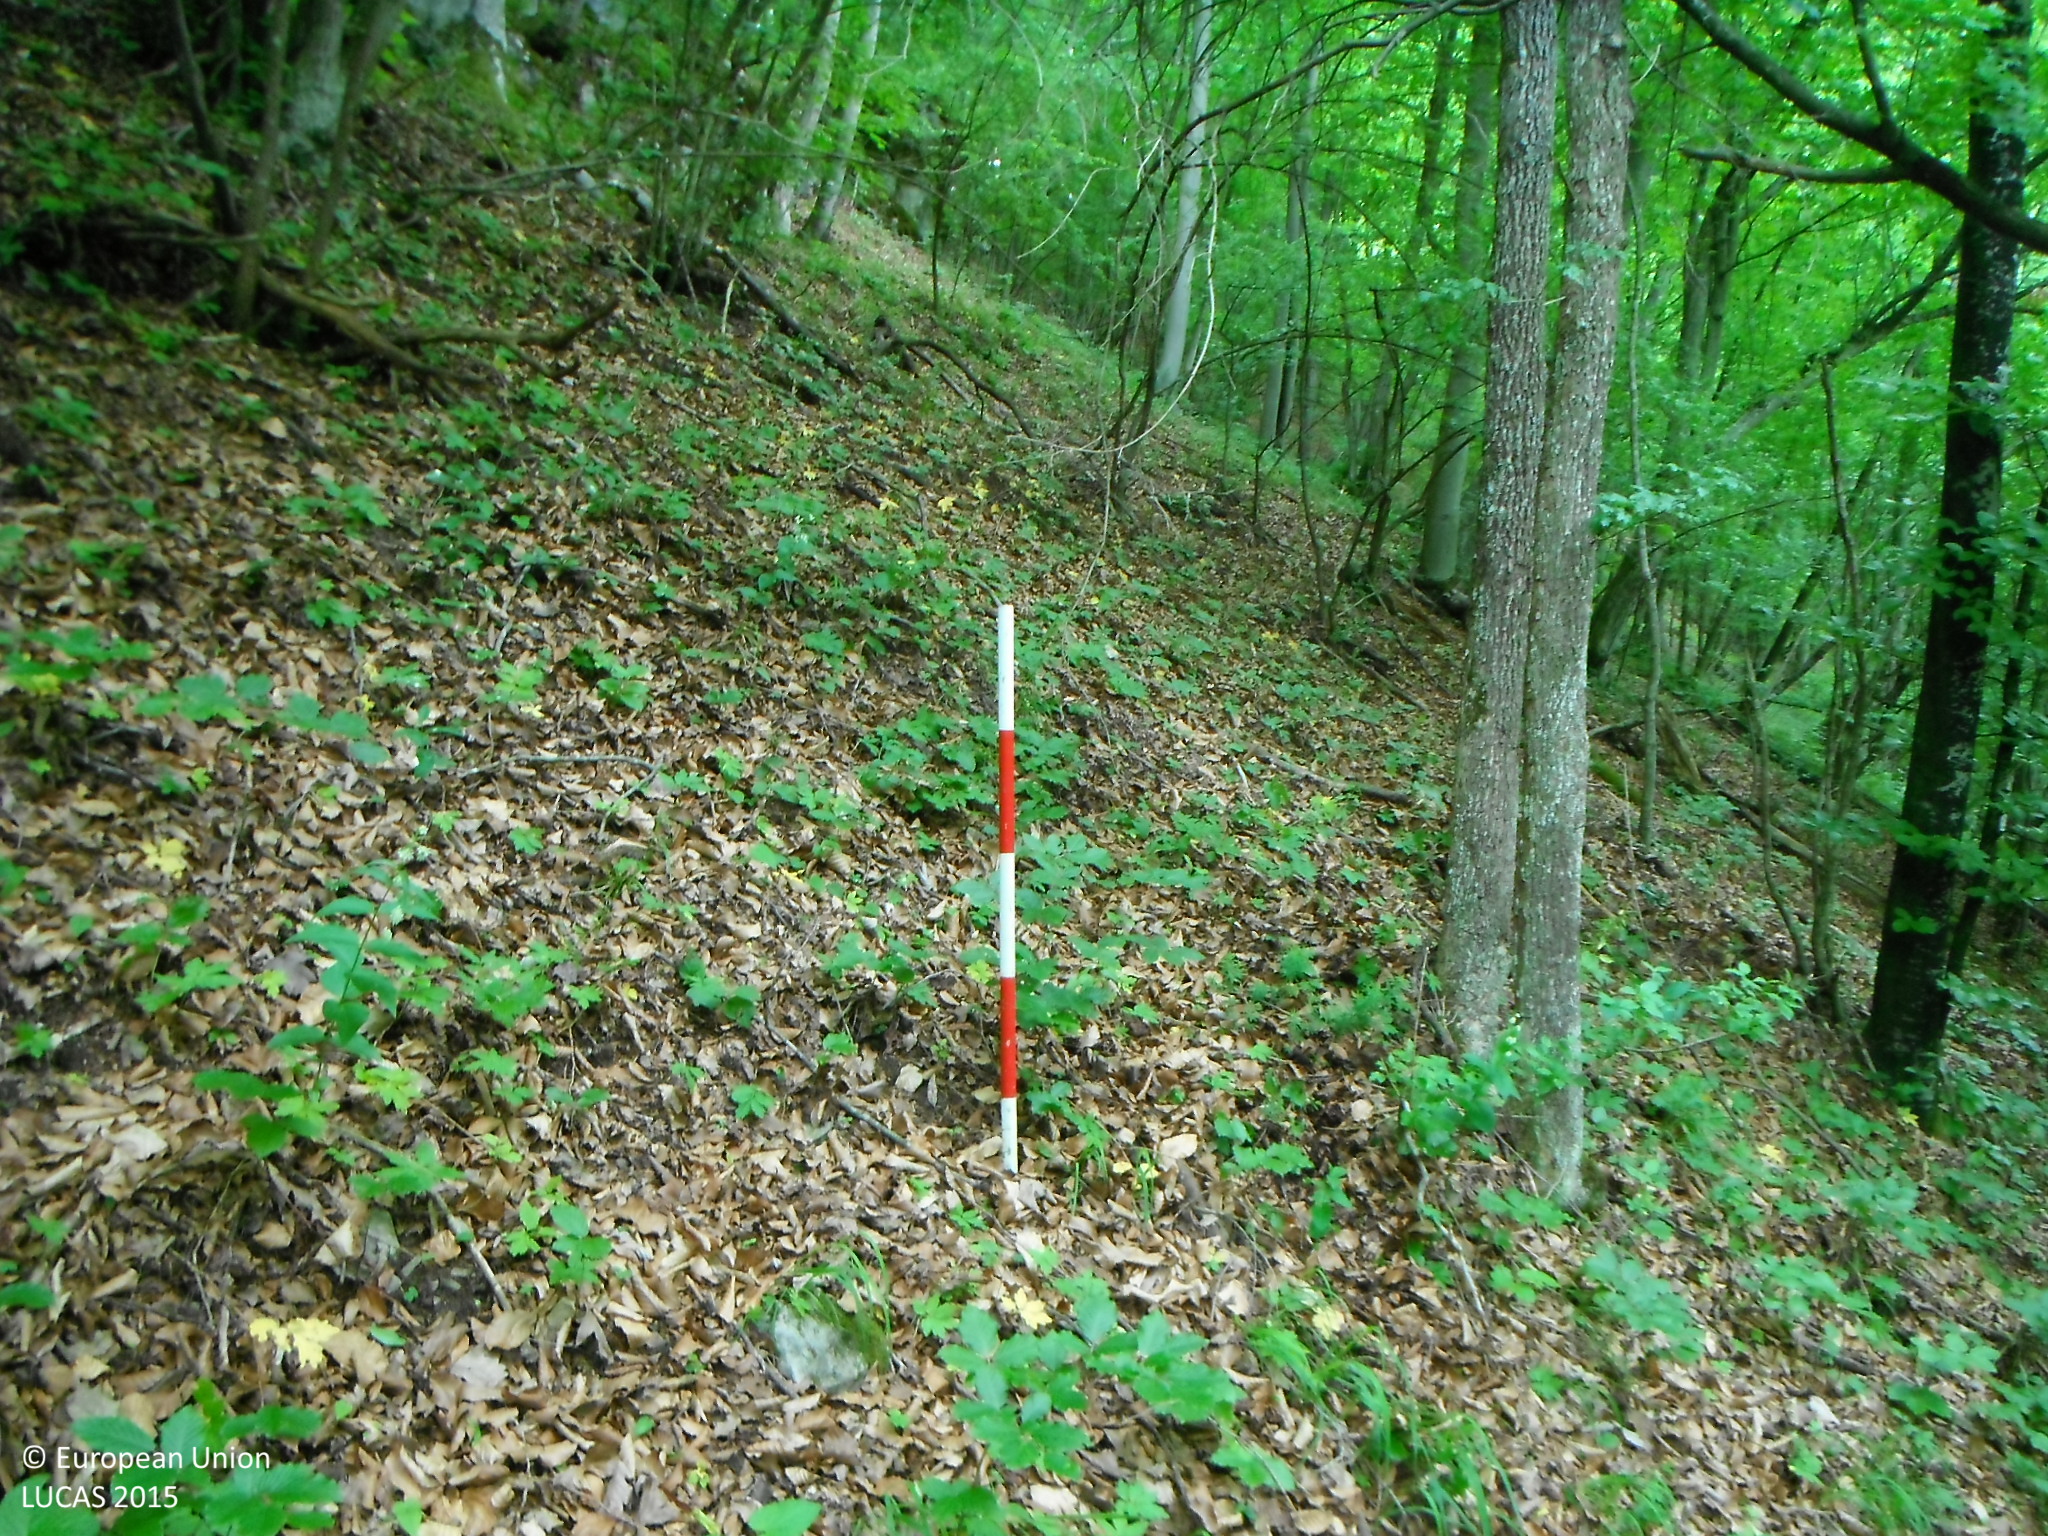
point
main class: Woodland
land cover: Broadleaved woodland
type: beech forest
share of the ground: > 75 %
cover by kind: broadleaved forest trees 100 %
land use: Forestry
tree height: > 5 m
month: June
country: SK
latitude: 48.7544
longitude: 19.2865
